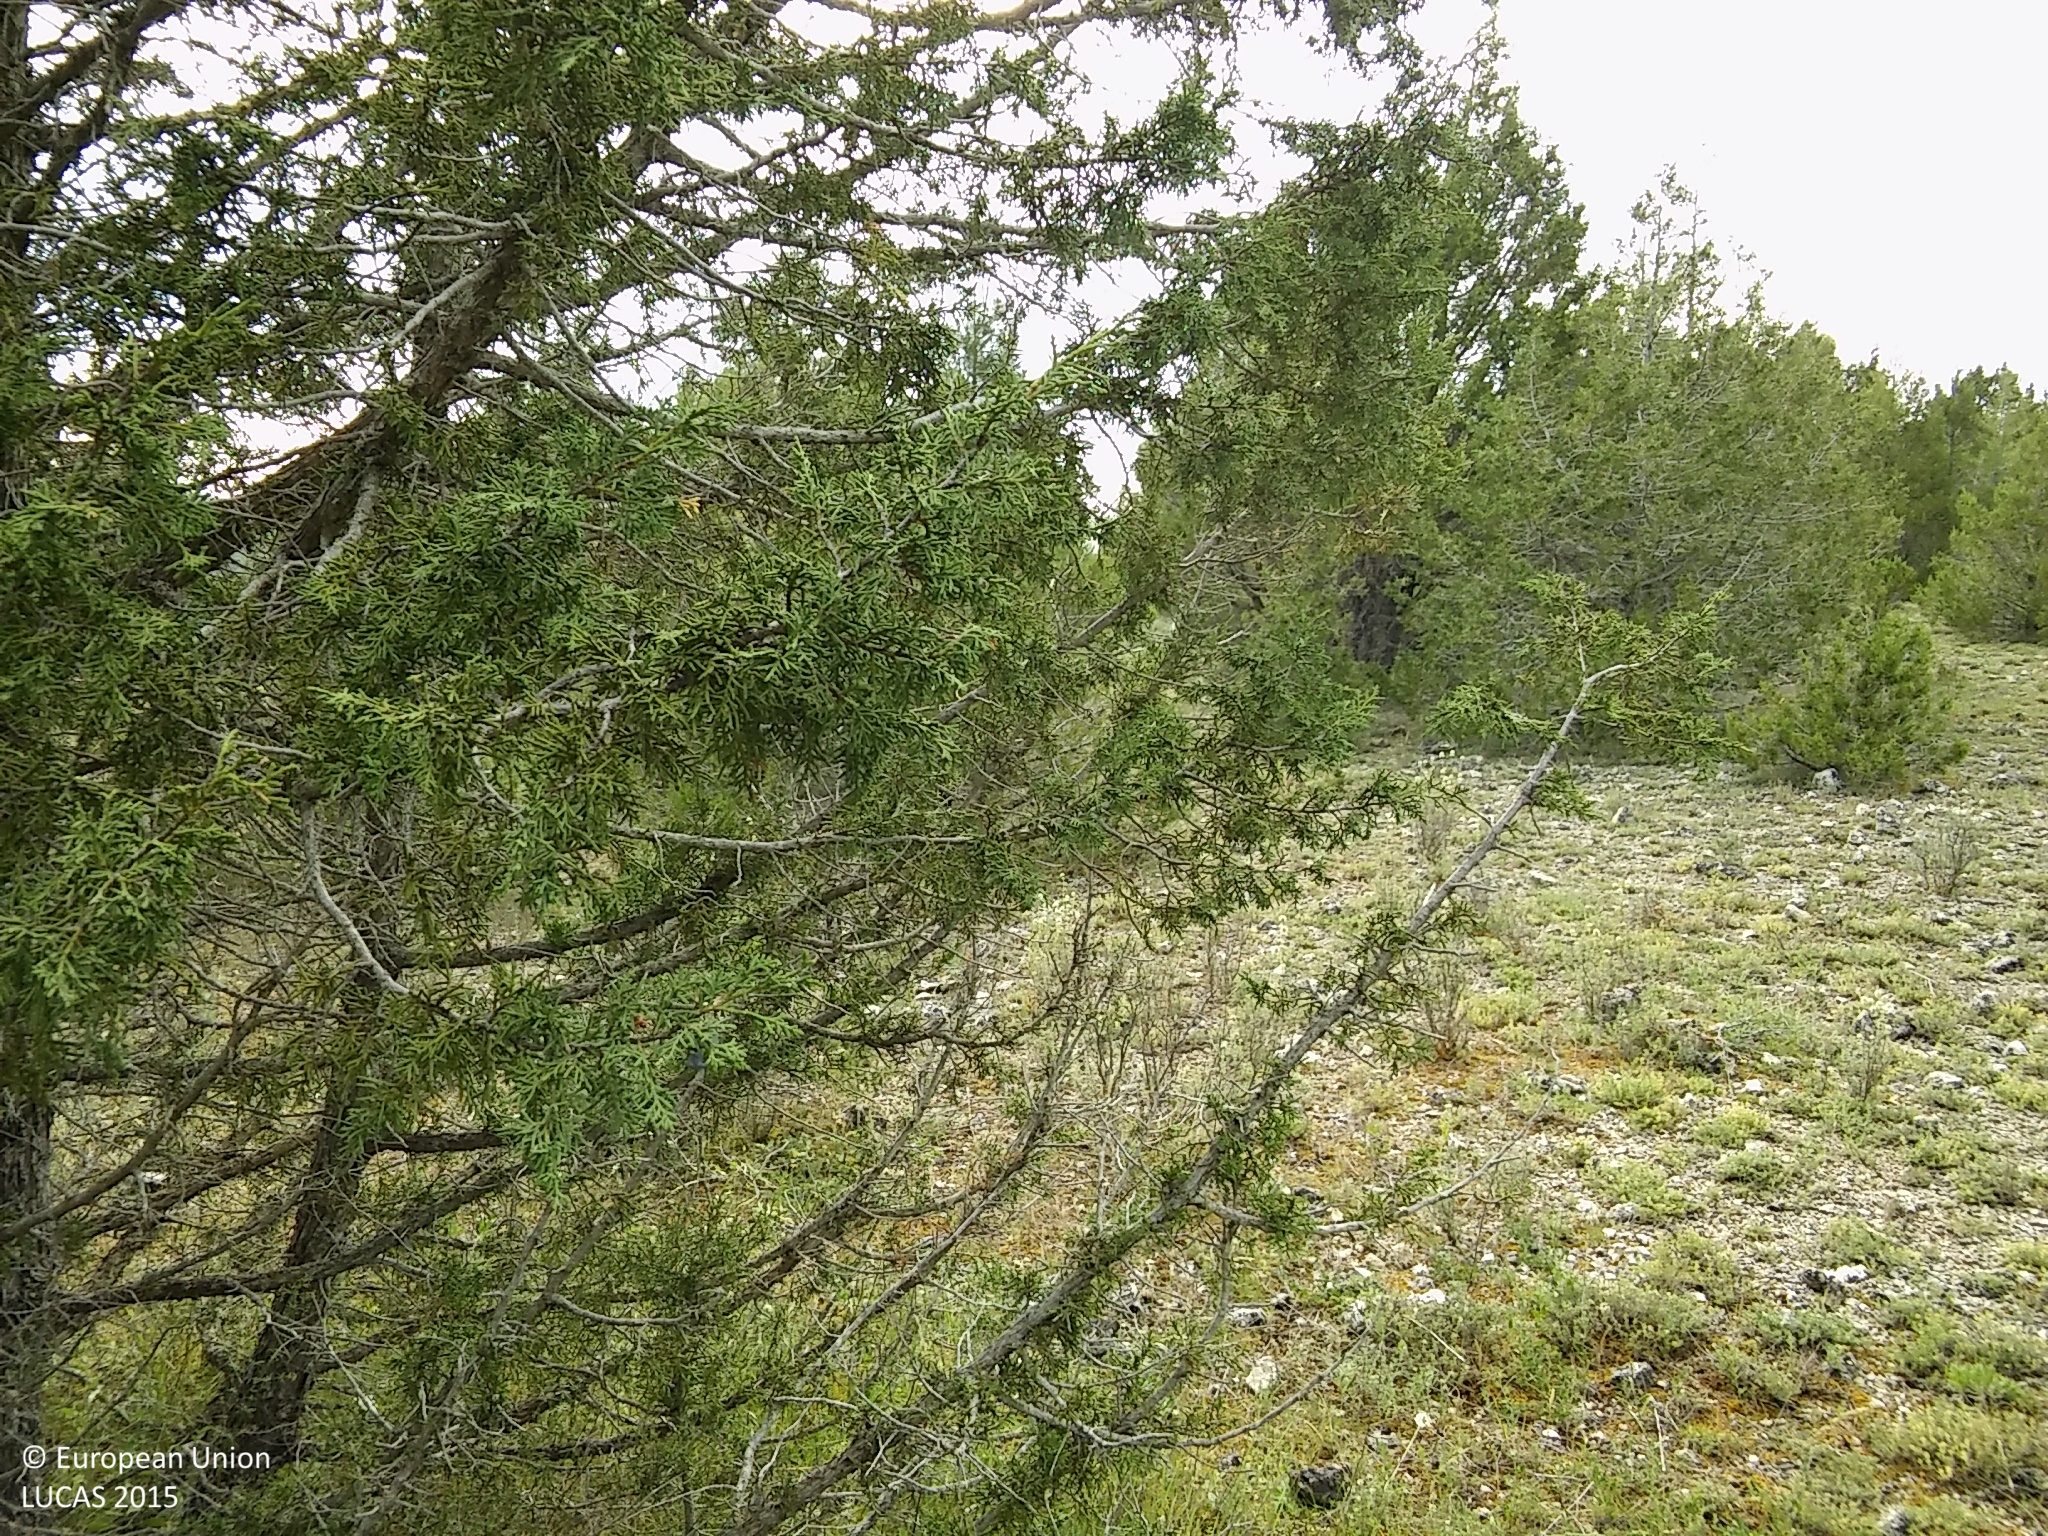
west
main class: Woodland
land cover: Other coniferous woodland
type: coniferous forest of the mediterranean region
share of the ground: 25 - 50 %
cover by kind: coniferous forest trees 30 %, shrubs 20 %, lichens and mosses 20 %, unconsolidated bare surface 20 %, herbaceous plants 10 %
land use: Forestry
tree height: > 5 m
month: June
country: ES
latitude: 41.1765
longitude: -3.6474
